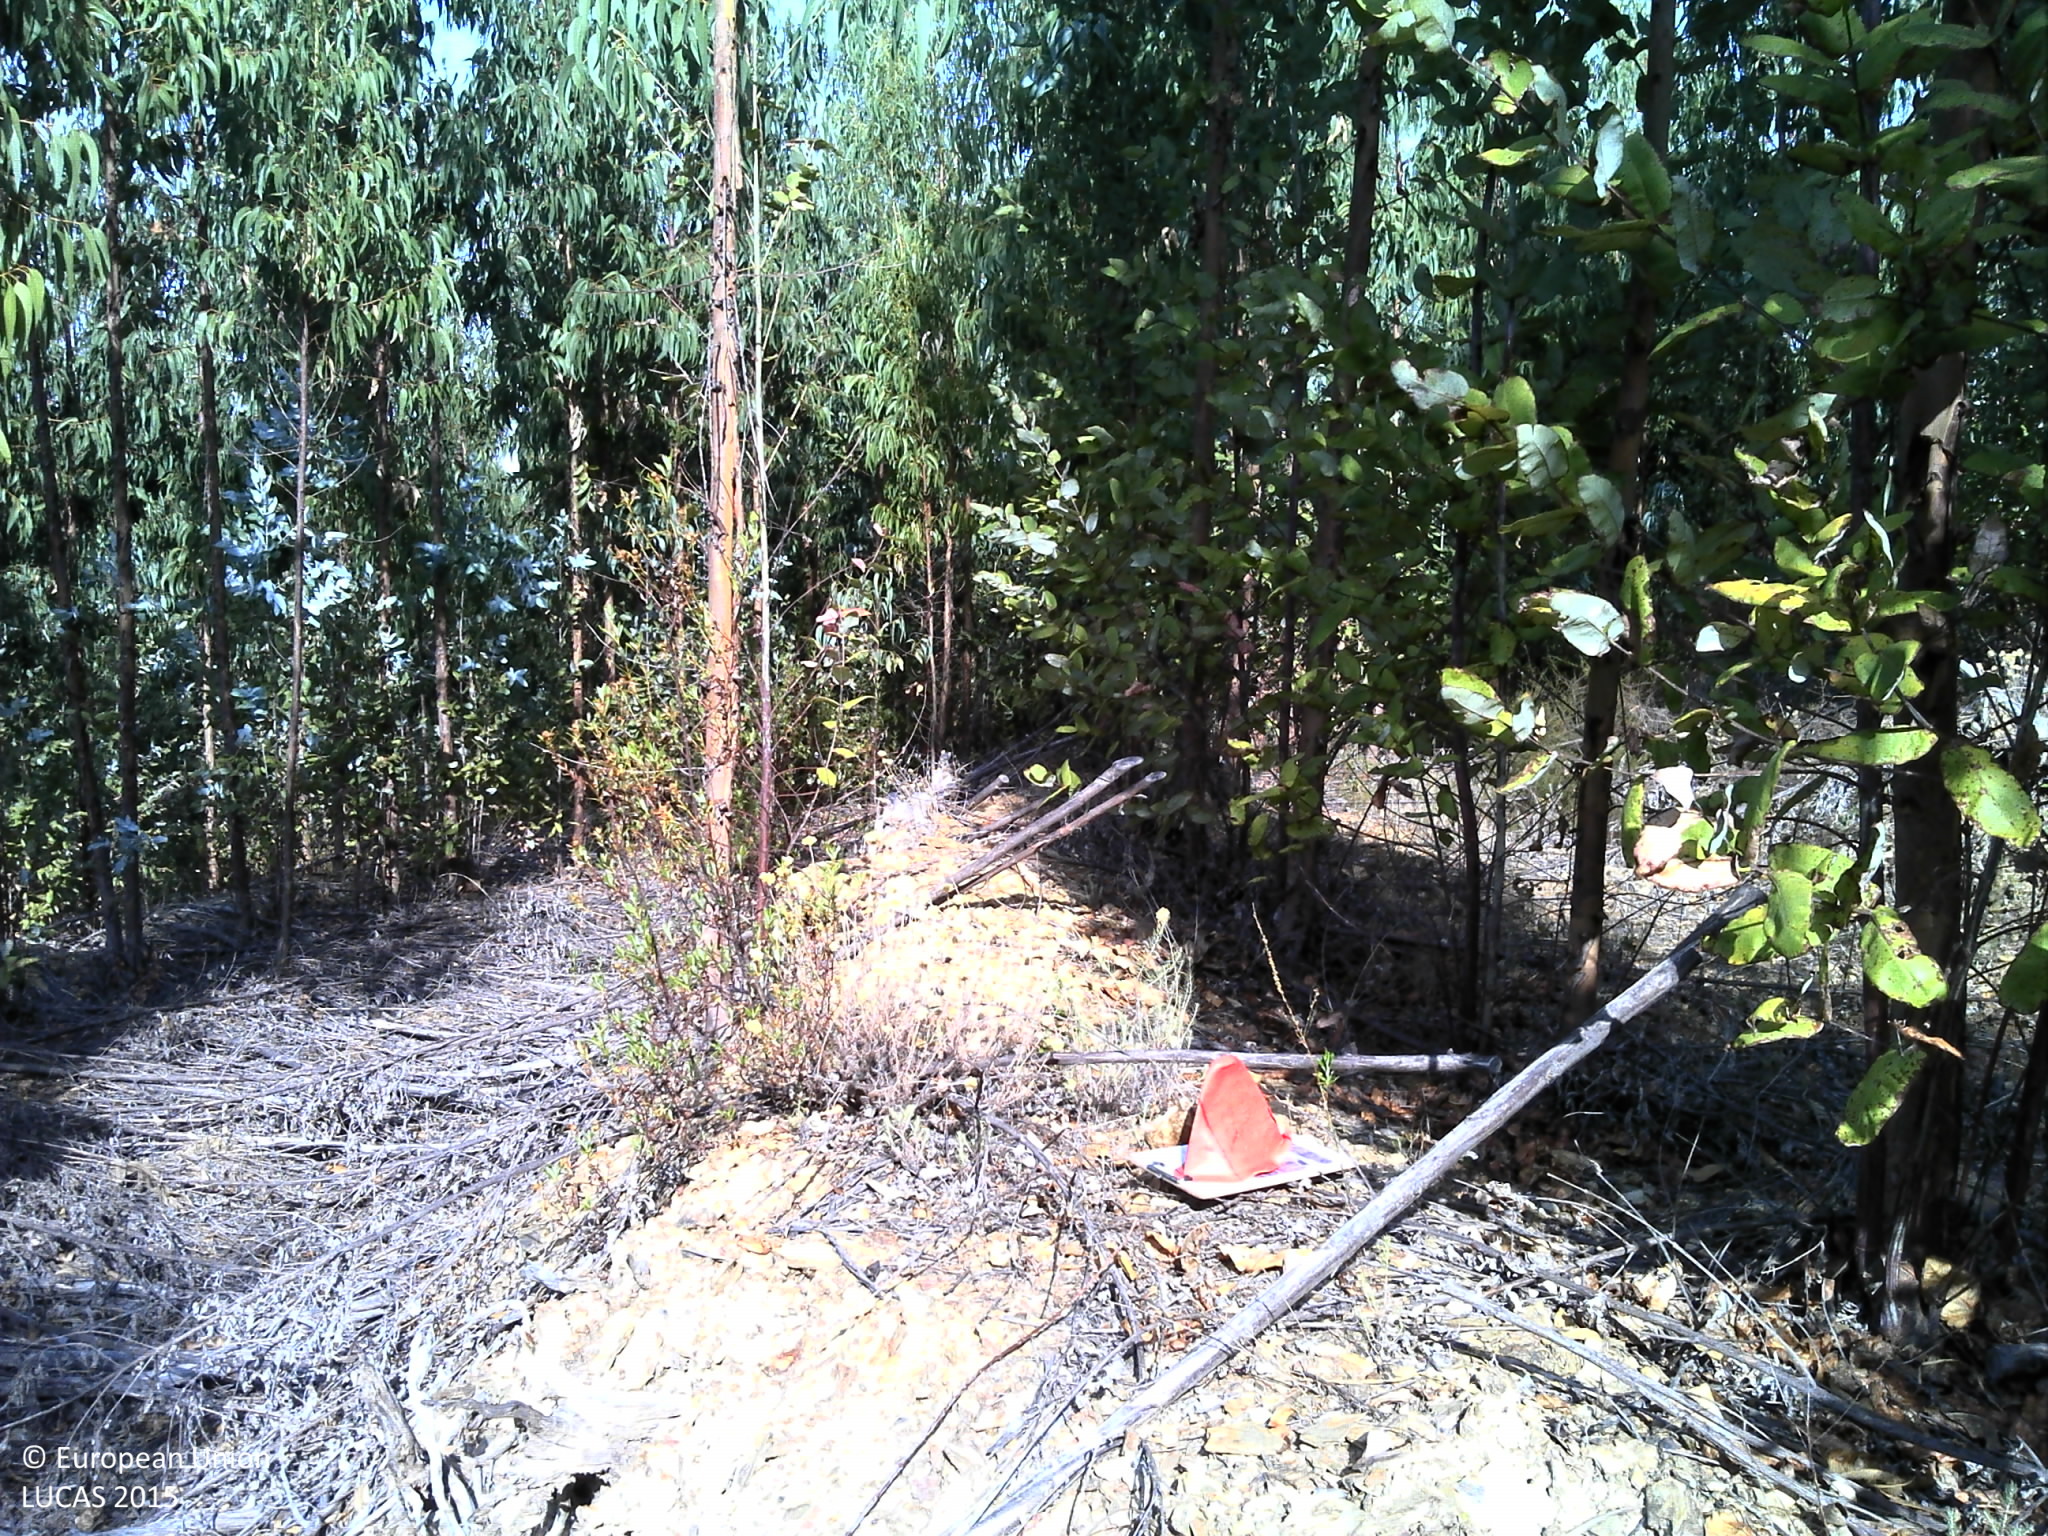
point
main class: Woodland
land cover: Broadleaved woodland
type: exotic forest
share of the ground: 50 - 75 %
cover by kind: broadleaved forest trees 50 %, consolidated bare surface 45 %, herbaceous plants 5 %
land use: Forestry
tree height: > 5 m
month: July
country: PT
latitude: 37.6790
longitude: -8.4839
